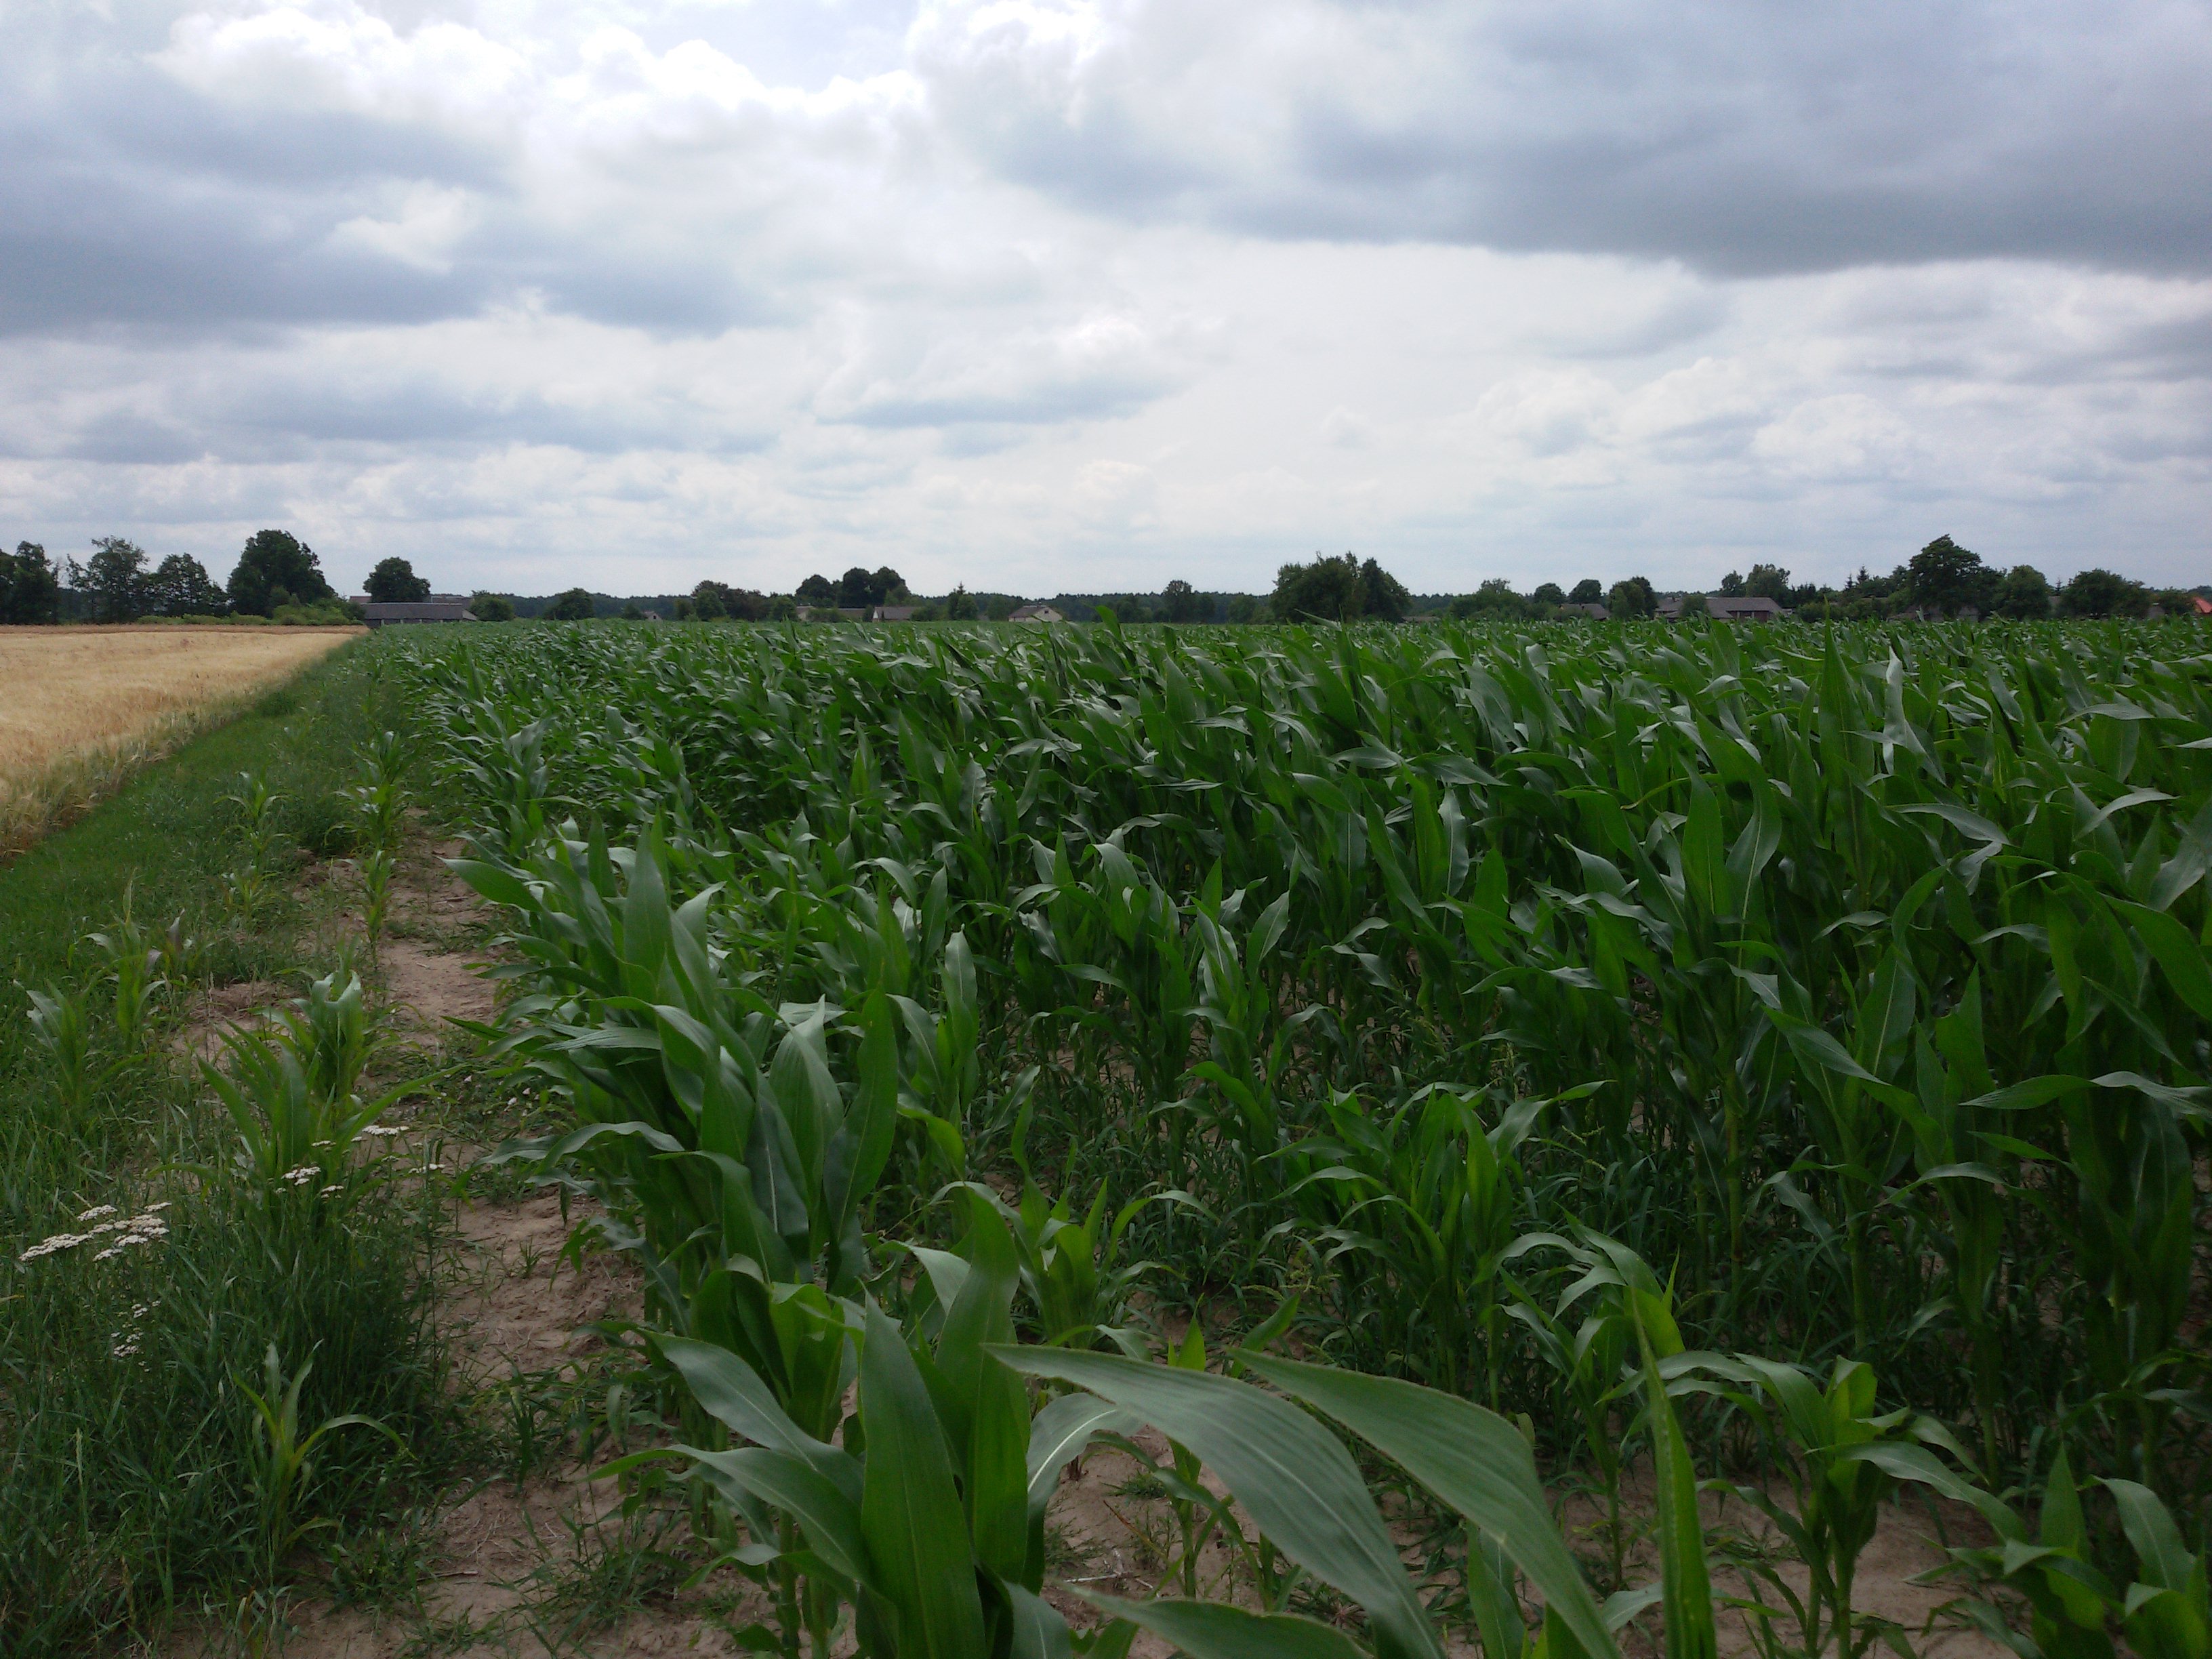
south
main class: Cropland
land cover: Maize
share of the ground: > 75 %
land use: Agriculture (excluding fallow land and kitchen gardens)
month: July
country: PL
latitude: 51.7998
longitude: 22.8774
